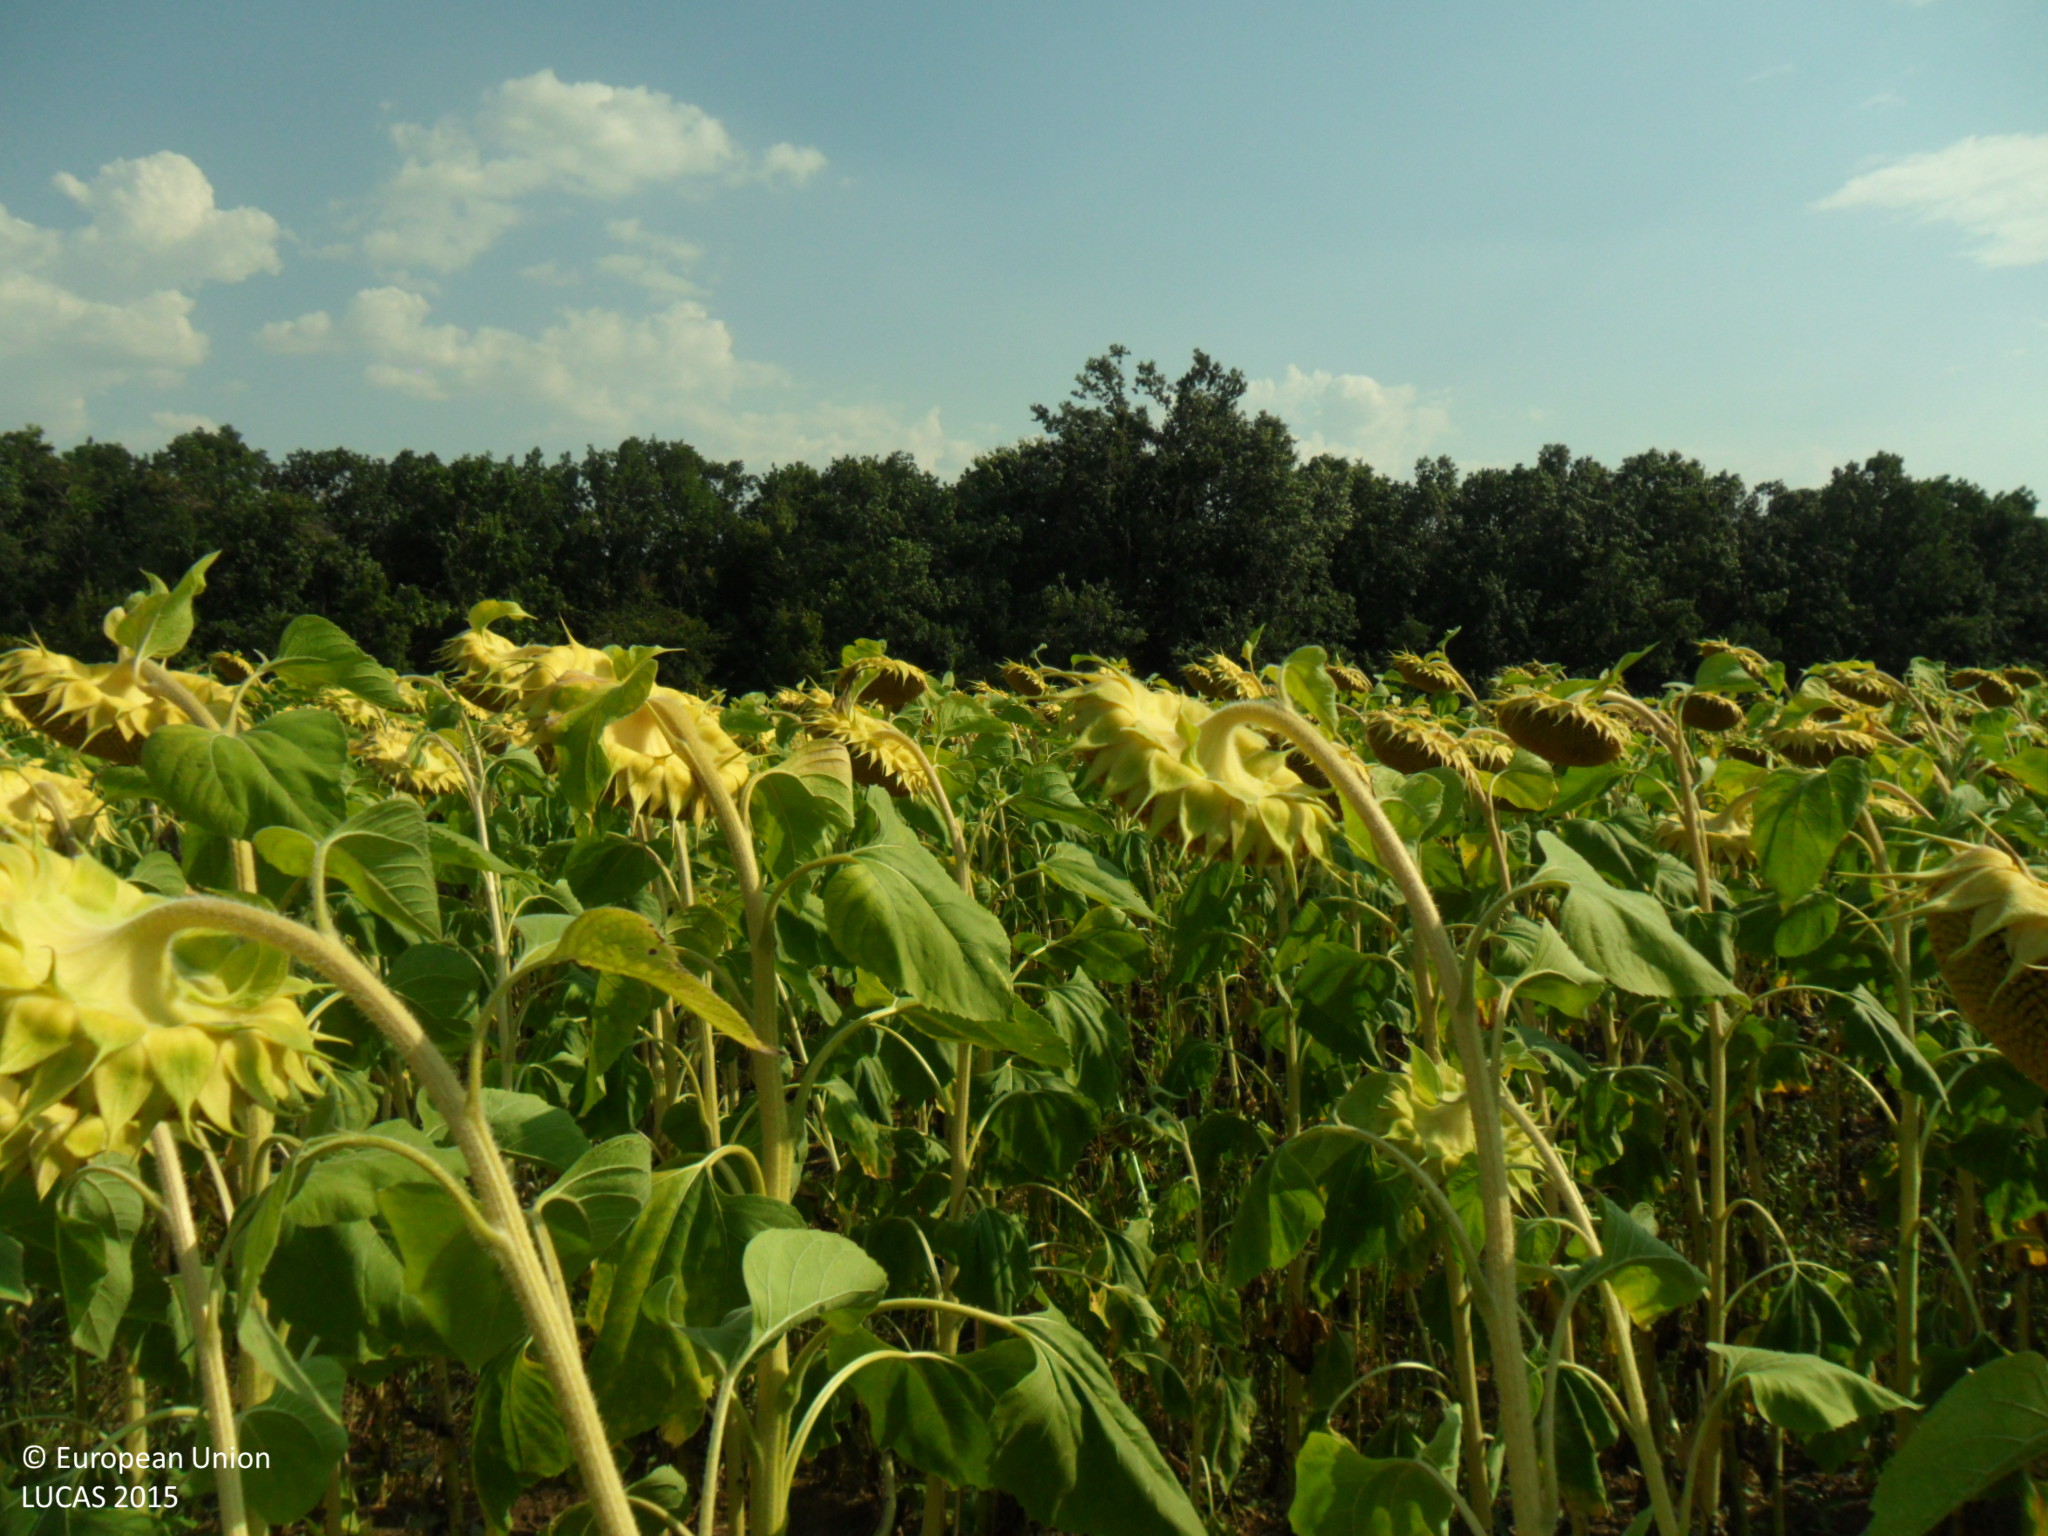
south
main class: Cropland
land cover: Sunflower
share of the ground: > 75 %
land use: Agriculture (excluding fallow land and kitchen gardens)
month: August
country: BG
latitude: 43.4295
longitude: 26.5723
